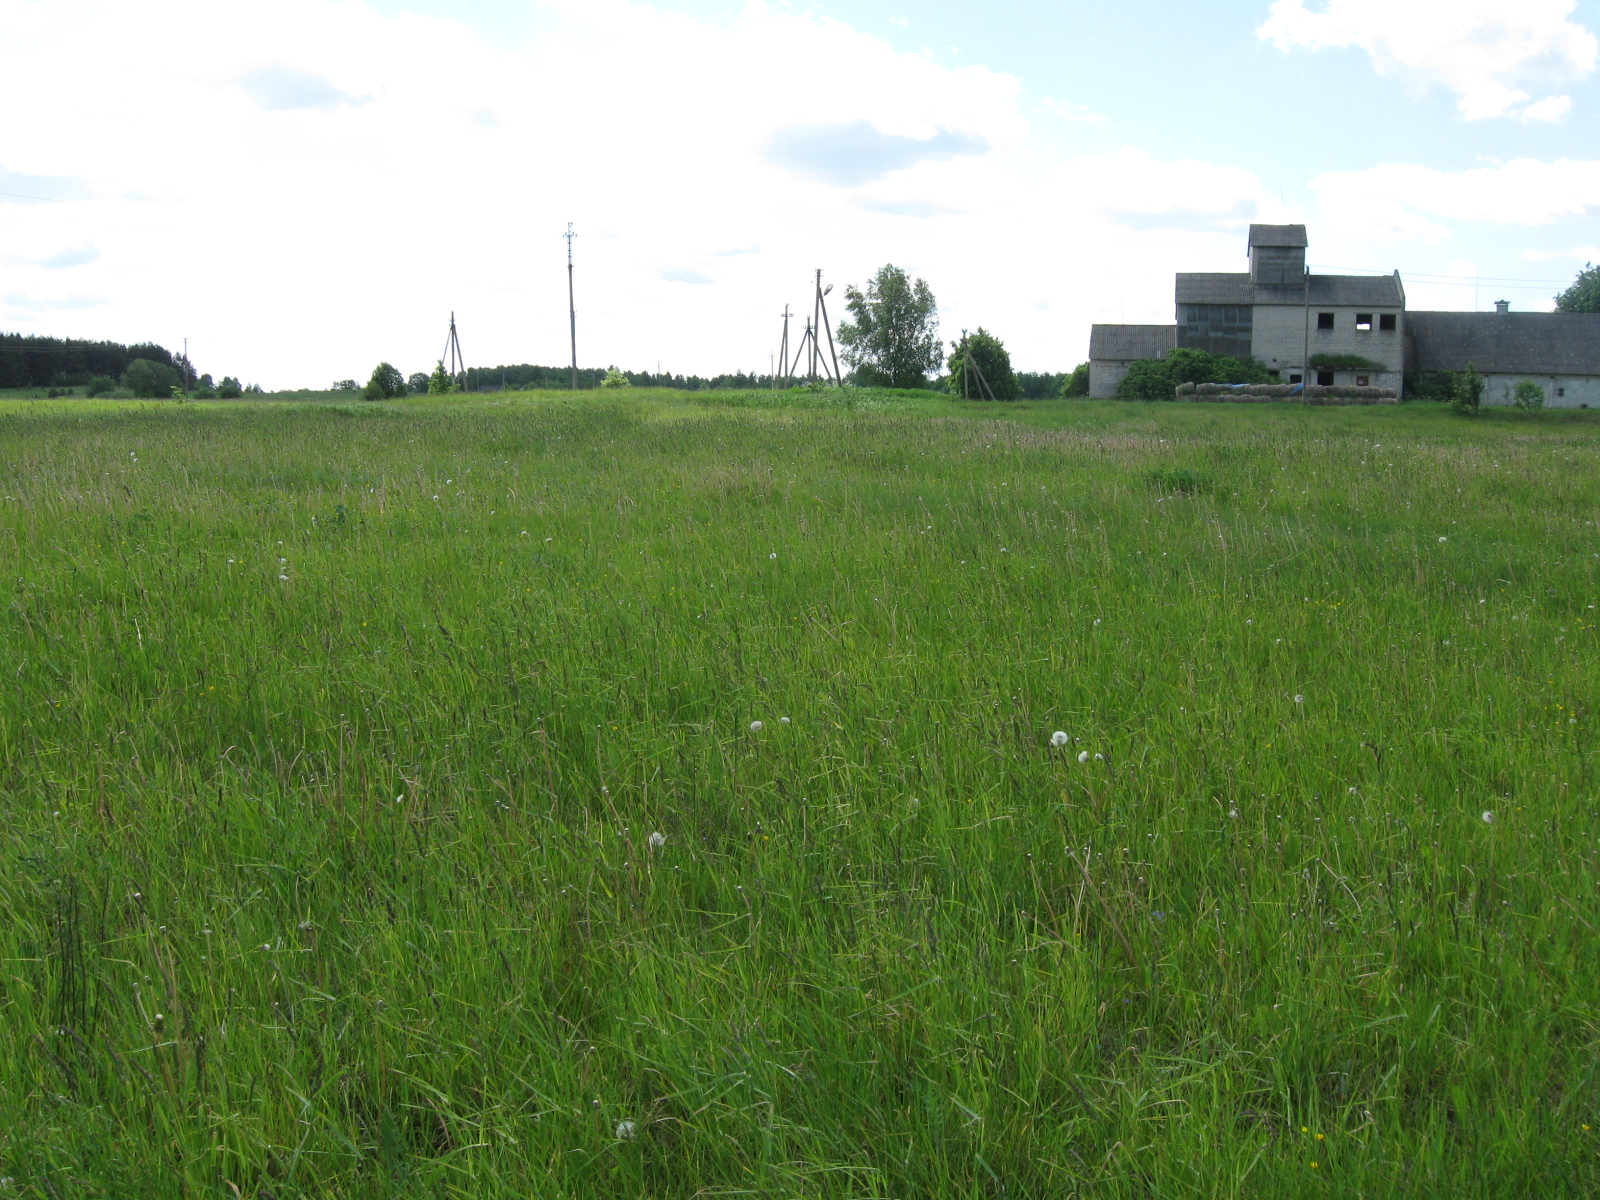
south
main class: Grassland
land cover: Grassland without tree/shrub cover
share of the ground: > 75 %
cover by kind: herbaceous plants 95 %, consolidated bare surface 5 %
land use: Agriculture (excluding fallow land and kitchen gardens)
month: May
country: LT
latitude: 54.3141
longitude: 23.2197
